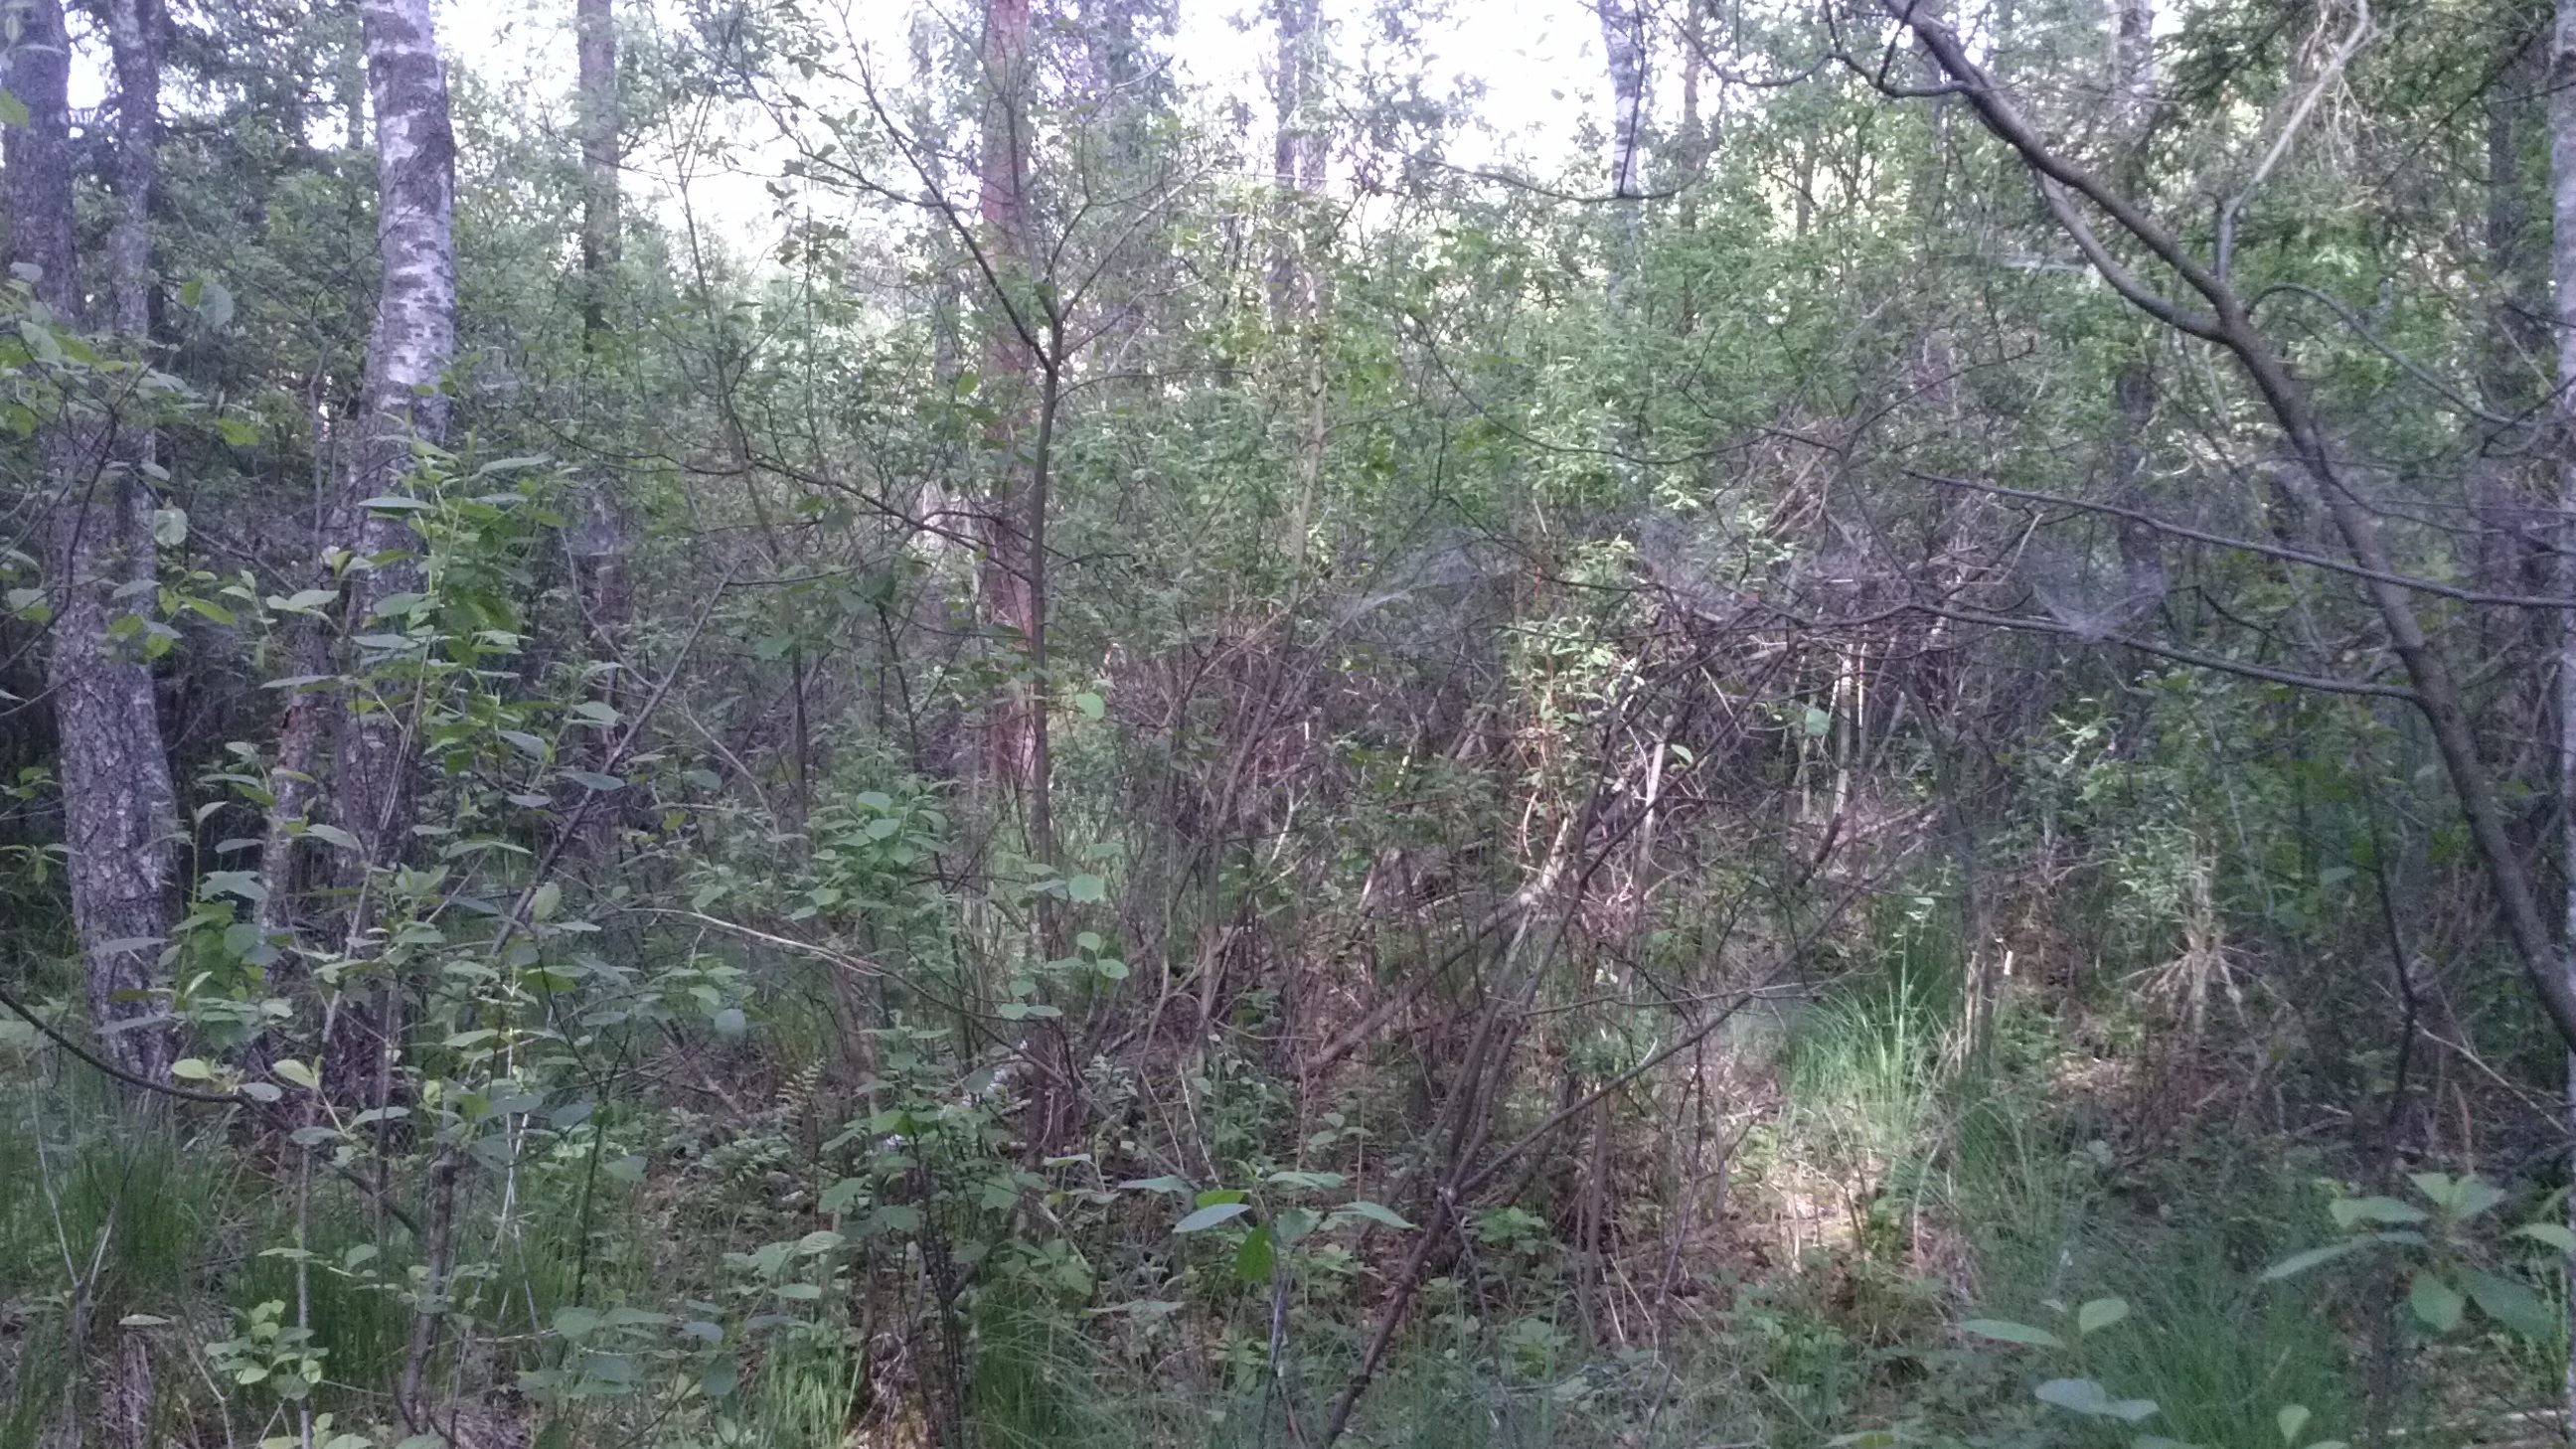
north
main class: Woodland
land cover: Broadleaved woodland
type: non-riverine alder, birch or aspen forest
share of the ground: > 75 %
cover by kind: broadleaved forest trees 85 %, coniferous forest trees 5 %, shrubs 5 %, herbaceous plants 5 %
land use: Forestry
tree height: > 5 m
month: June
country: LV
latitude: 56.3835
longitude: 27.4258
